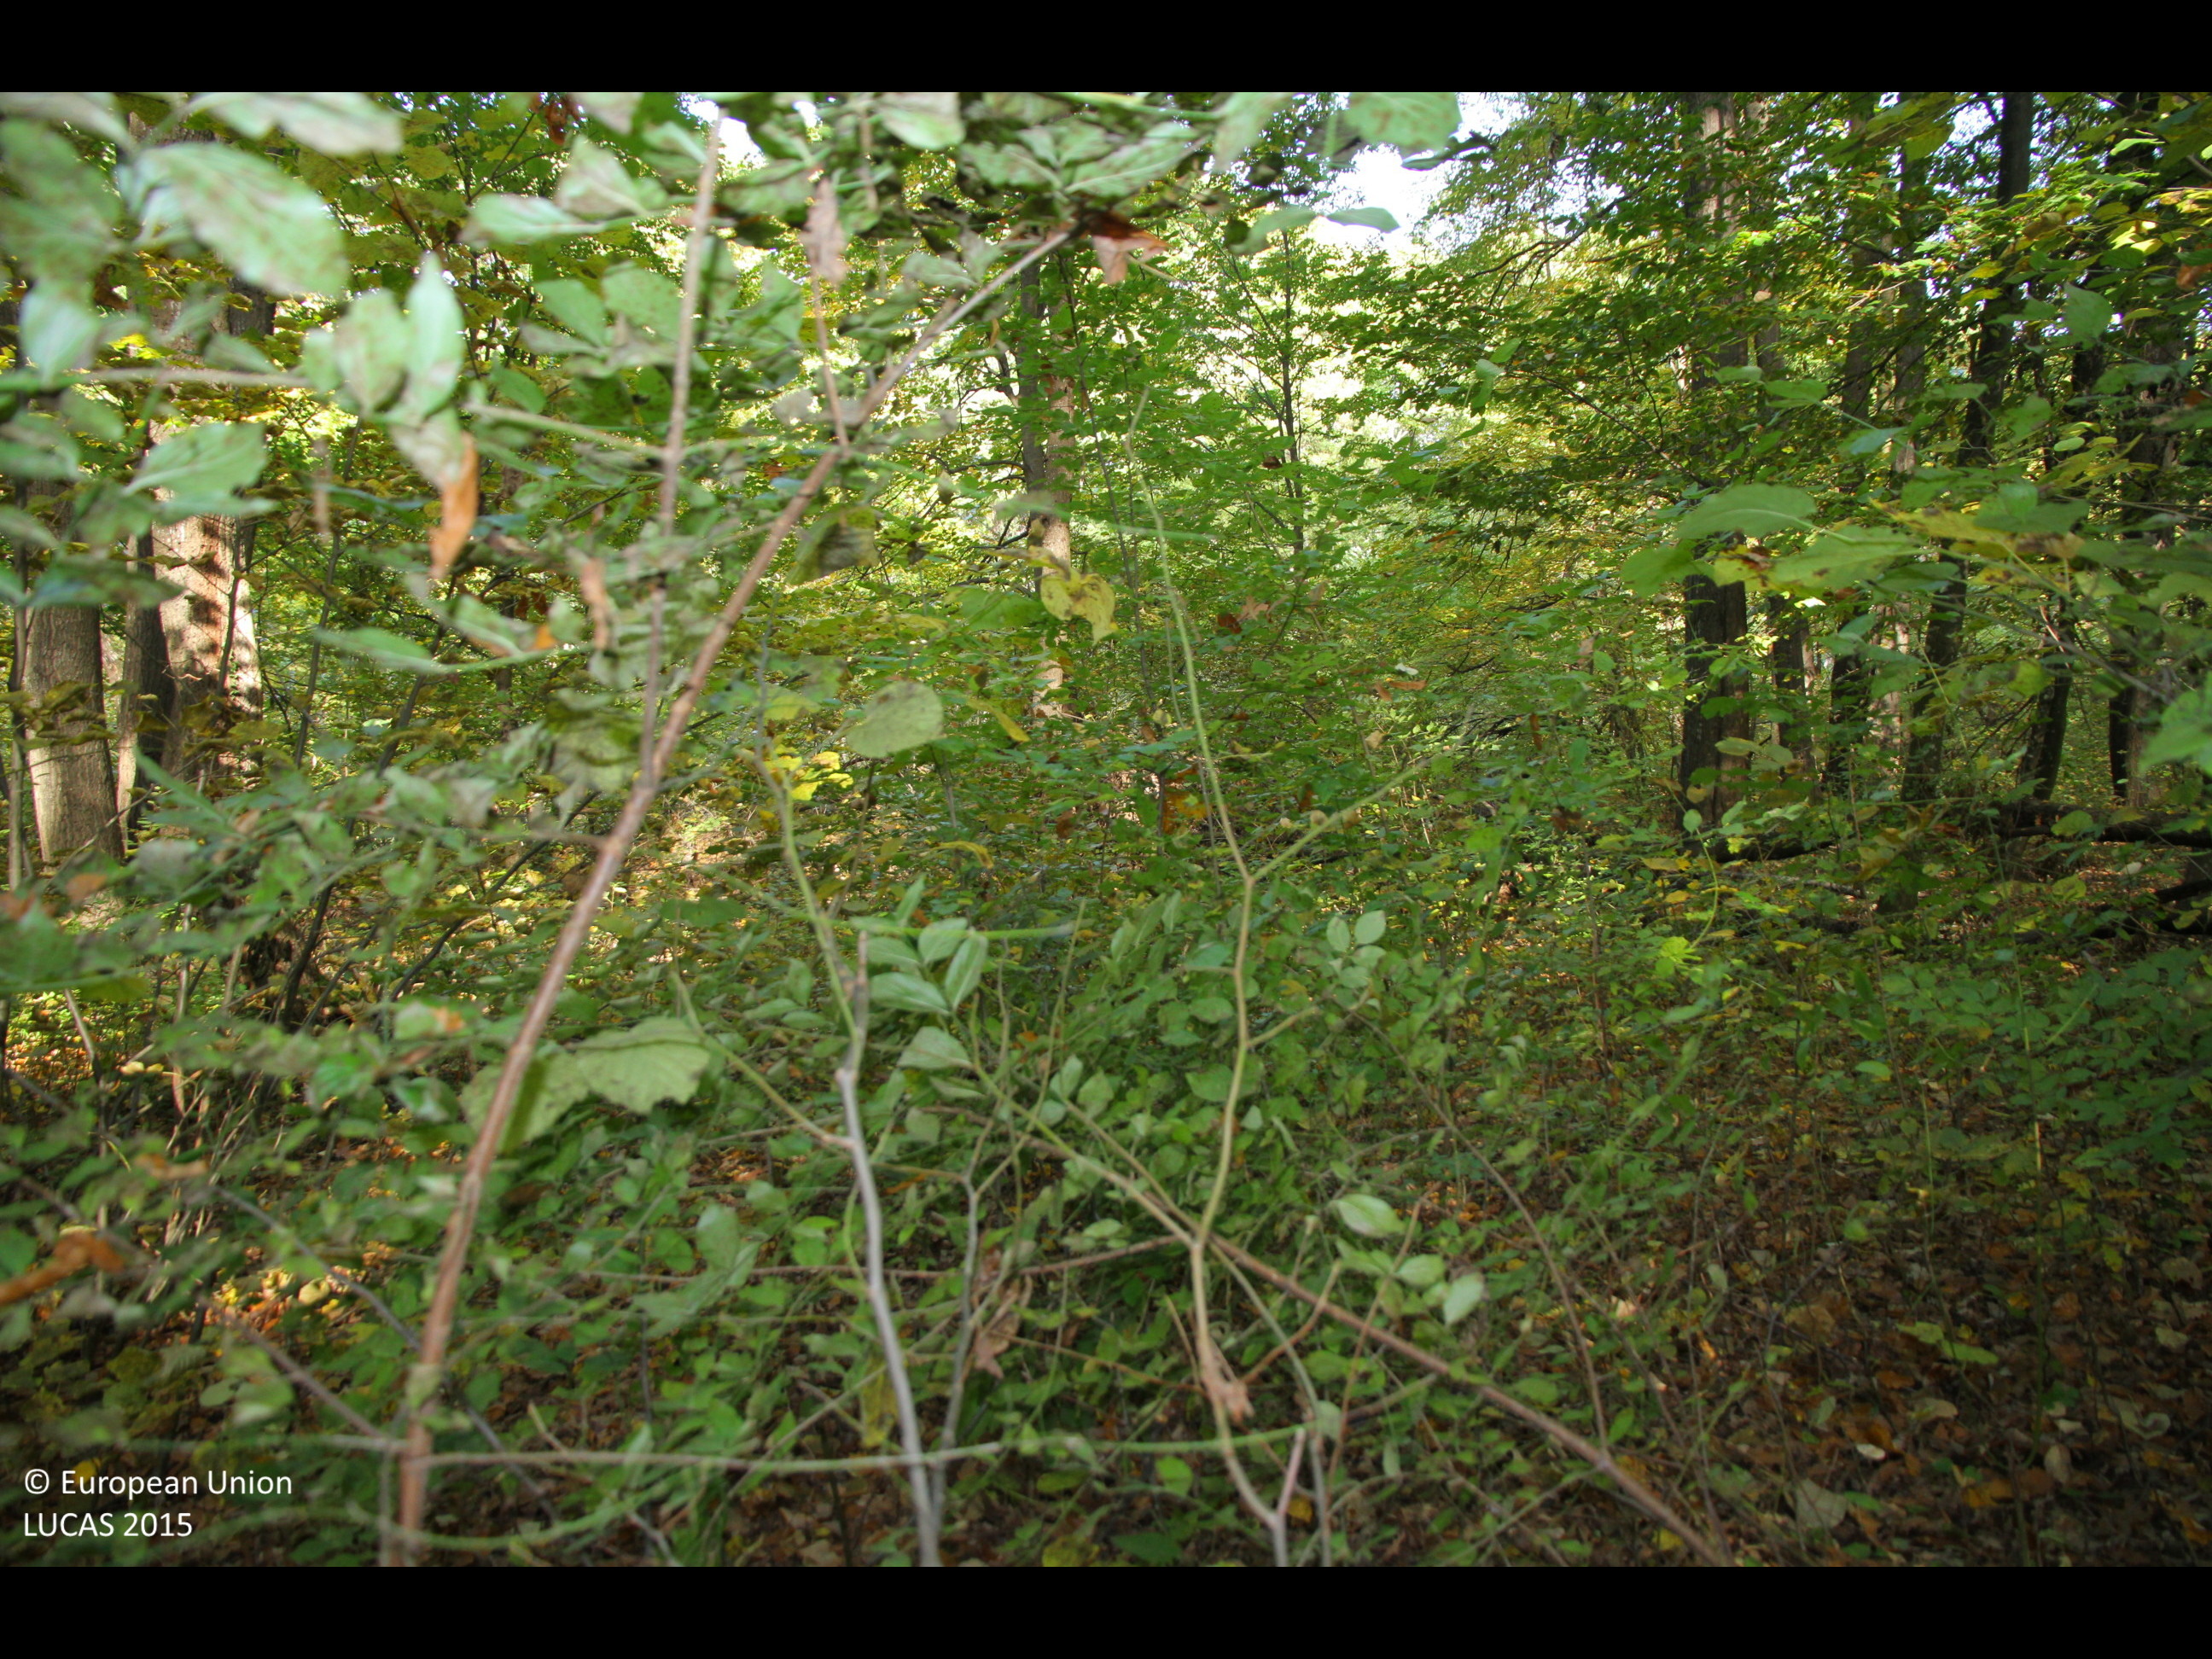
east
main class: Woodland
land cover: Broadleaved woodland
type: mesophytic deciduous forest
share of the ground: > 75 %
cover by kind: broadleaved forest trees 100 %
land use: Forestry
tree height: > 5 m
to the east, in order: Broadleaved woodland; Tracks; Broadleaved woodland
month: October
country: BG
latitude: 43.1726
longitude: 26.9020
